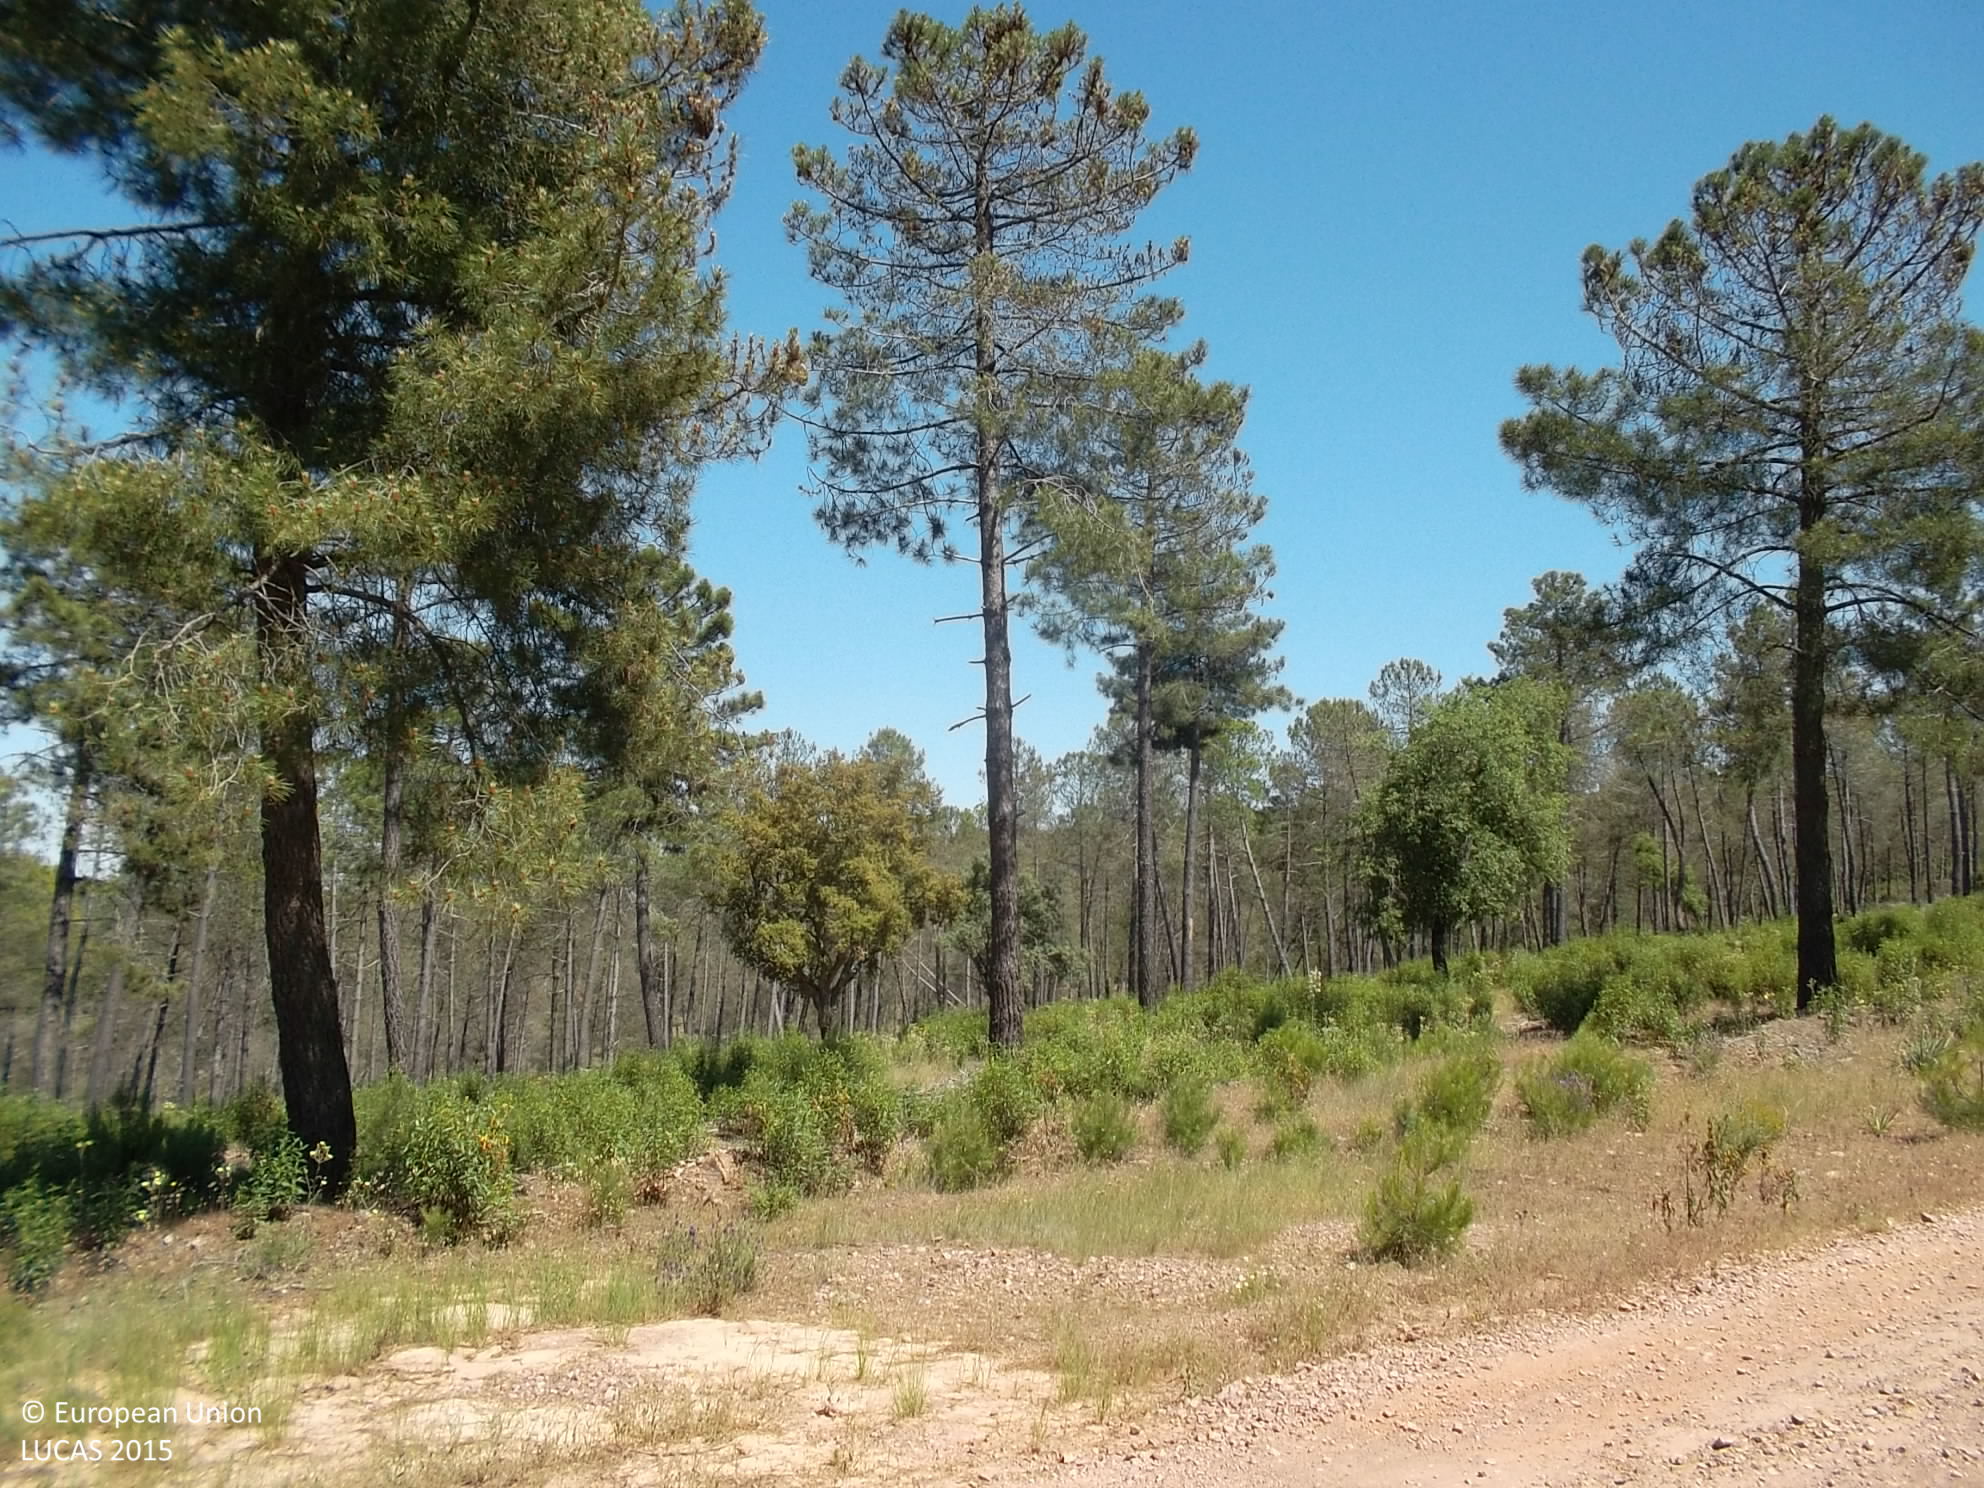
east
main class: Woodland
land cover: Pine dominated coniferous woodland
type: broadleaved evergreen forest
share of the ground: 25 - 50 %
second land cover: Spontaneously vegetated surfaces
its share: > 75 %
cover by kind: coniferous forest trees 40 %, herbaceous plants 30 %, consolidated bare surface 20 %, shrubs 10 %
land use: Forestry
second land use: Agriculture (excluding fallow land and kitchen gardens)
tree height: > 5 m
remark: Clear cut
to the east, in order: Pine dominated coniferous woodland; Spontaneously vegetated surfaces; Tracks; Pine dominated coniferous woodland; Spontaneously vegetated surfaces; Pine dominated coniferous woodland
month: May
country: ES
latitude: 38.8197
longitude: -4.4797
